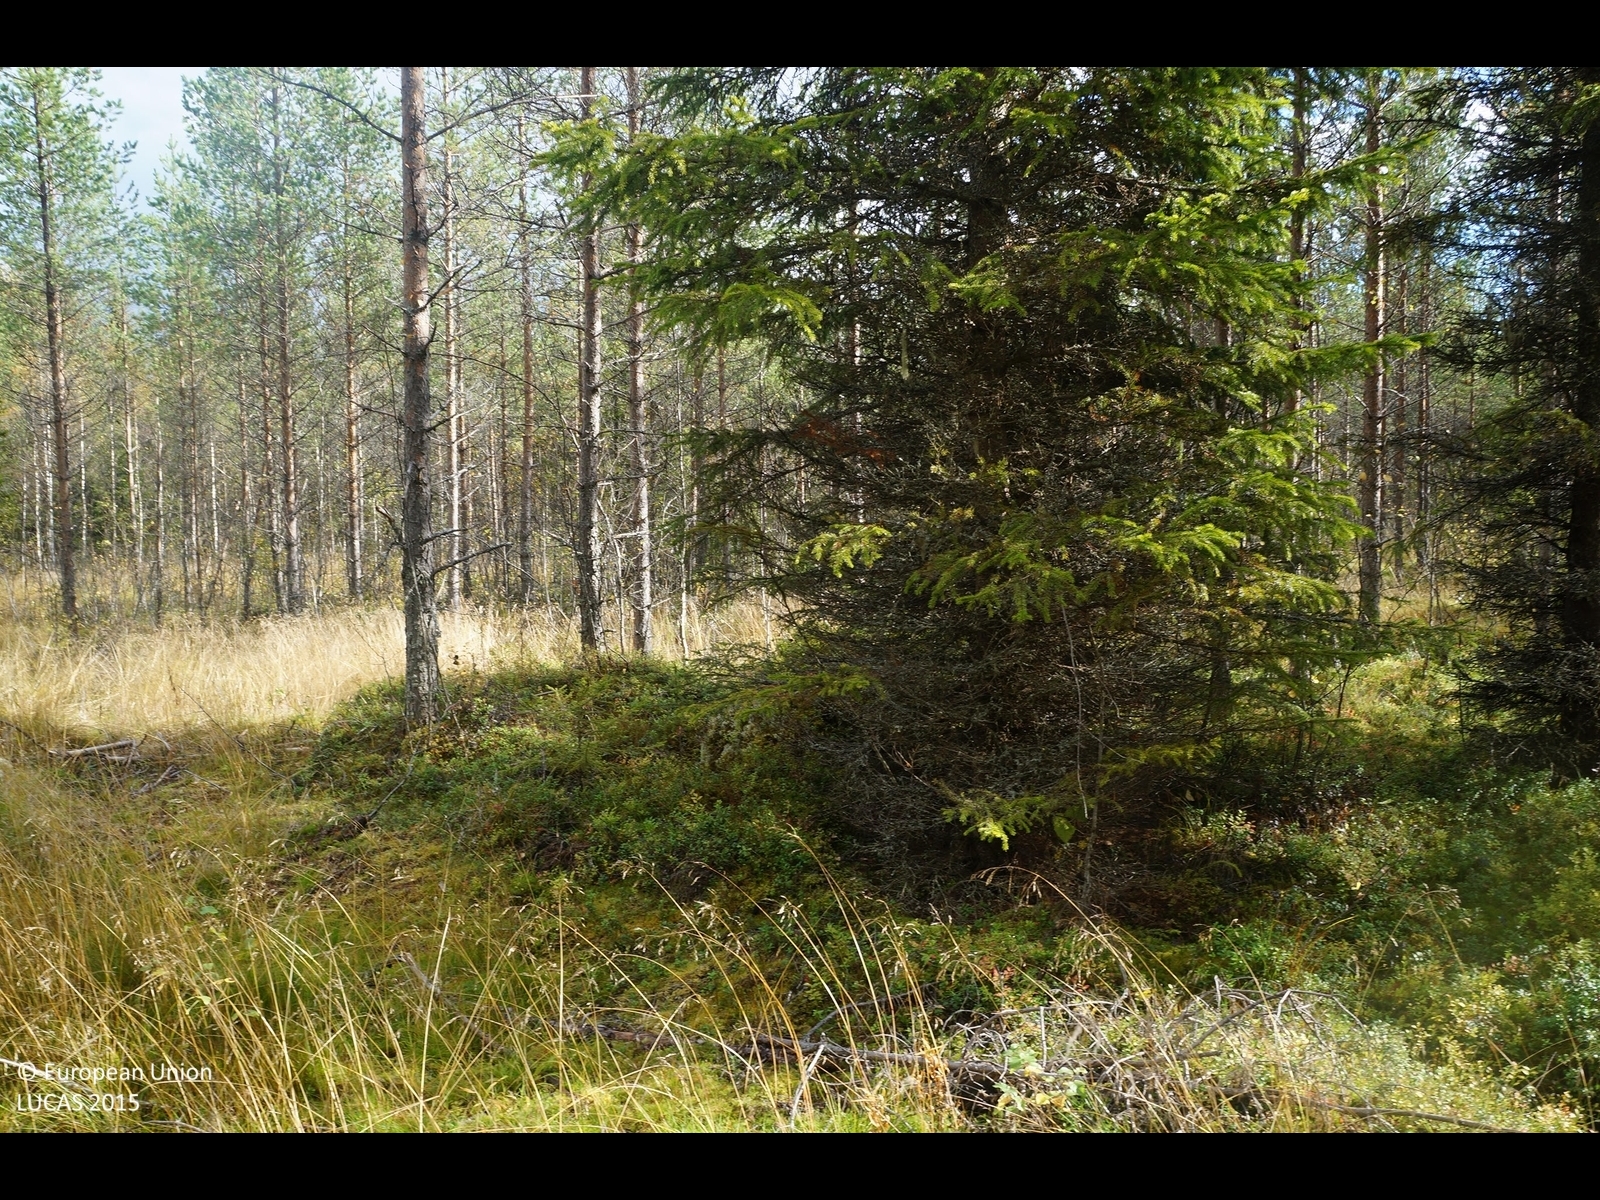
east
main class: Woodland
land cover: Pine dominated coniferous woodland
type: boreal forest
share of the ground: 50 - 75 %
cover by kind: coniferous forest trees 50 %, shrubs 20 %, lichens and mosses 20 %, herbaceous plants 10 %
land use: Forestry
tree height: > 5 m
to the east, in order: Pine dominated coniferous woodland; Tracks; Spruce dominated mixed woodland; Ditches and canals; Spruce dominated coniferous woodland; Tracks; Spruce dominated mixed woodland; Pine dominated coniferous woodland; Shrubland with sparse tree cover; Electric lines; Shrubland with sparse tree cover; Shrubland without tree cover; Ditches and canals; Shrubland without tree cover
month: September
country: FI
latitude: 64.4969
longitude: 24.7494
